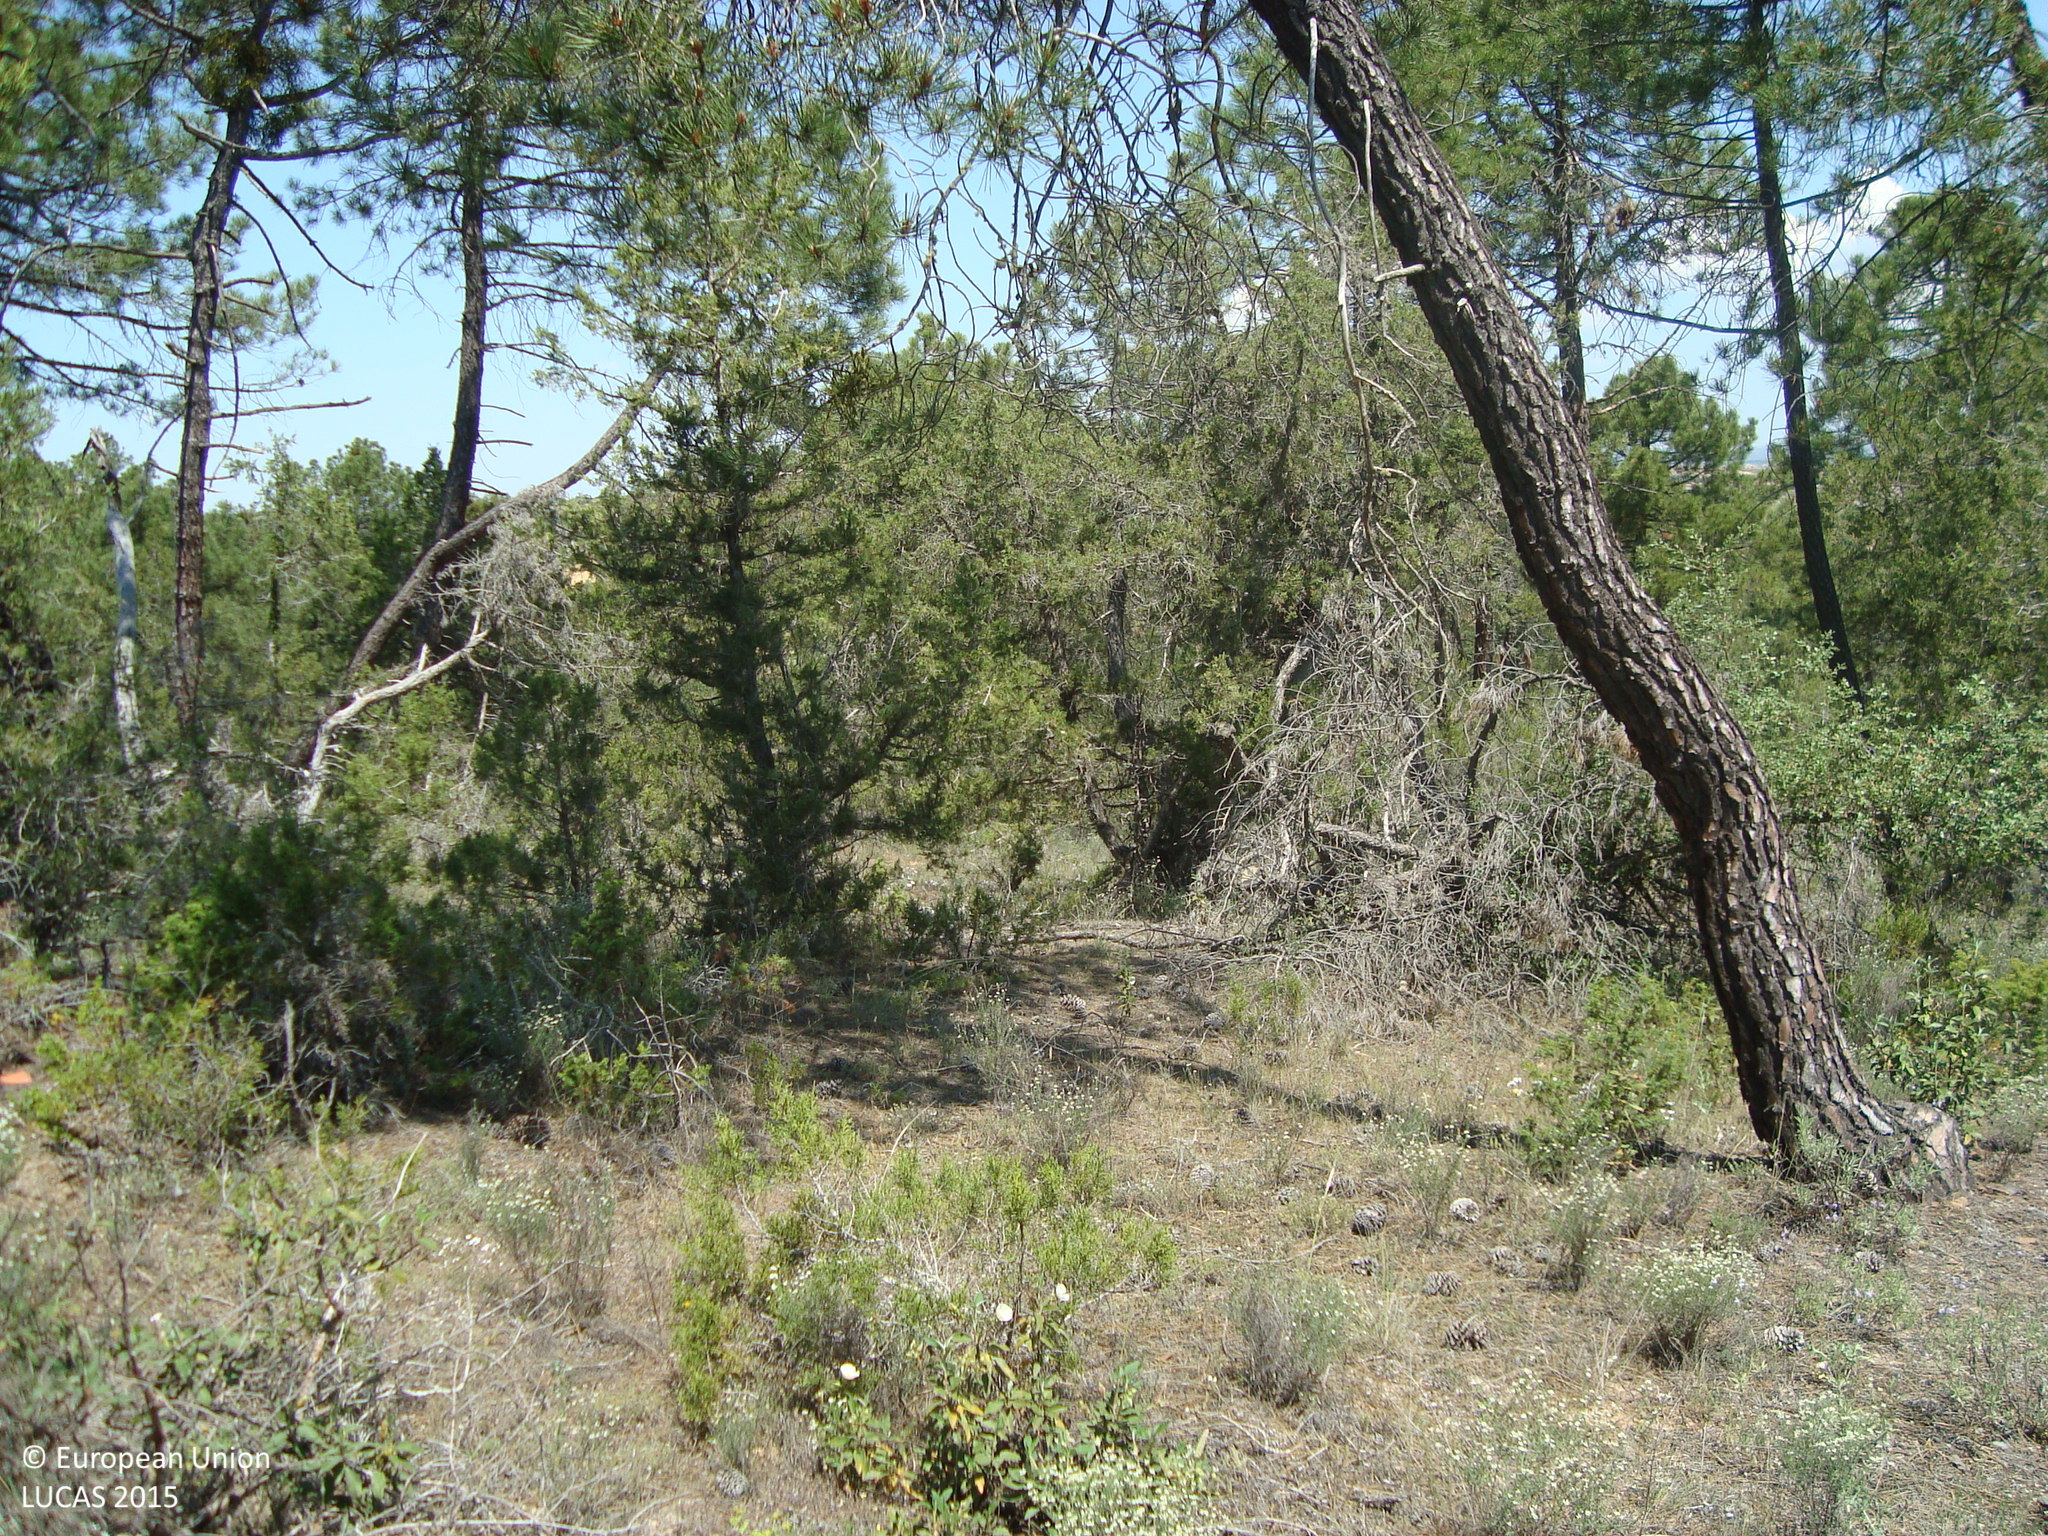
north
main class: Woodland
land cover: Pine dominated coniferous woodland
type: coniferous forest of the mediterranean region
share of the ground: 50 - 75 %
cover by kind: coniferous forest trees 55 %, shrubs 35 %, herbaceous plants 10 %
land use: Forestry
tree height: > 5 m
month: June
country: ES
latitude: 41.7237
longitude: -3.5265
